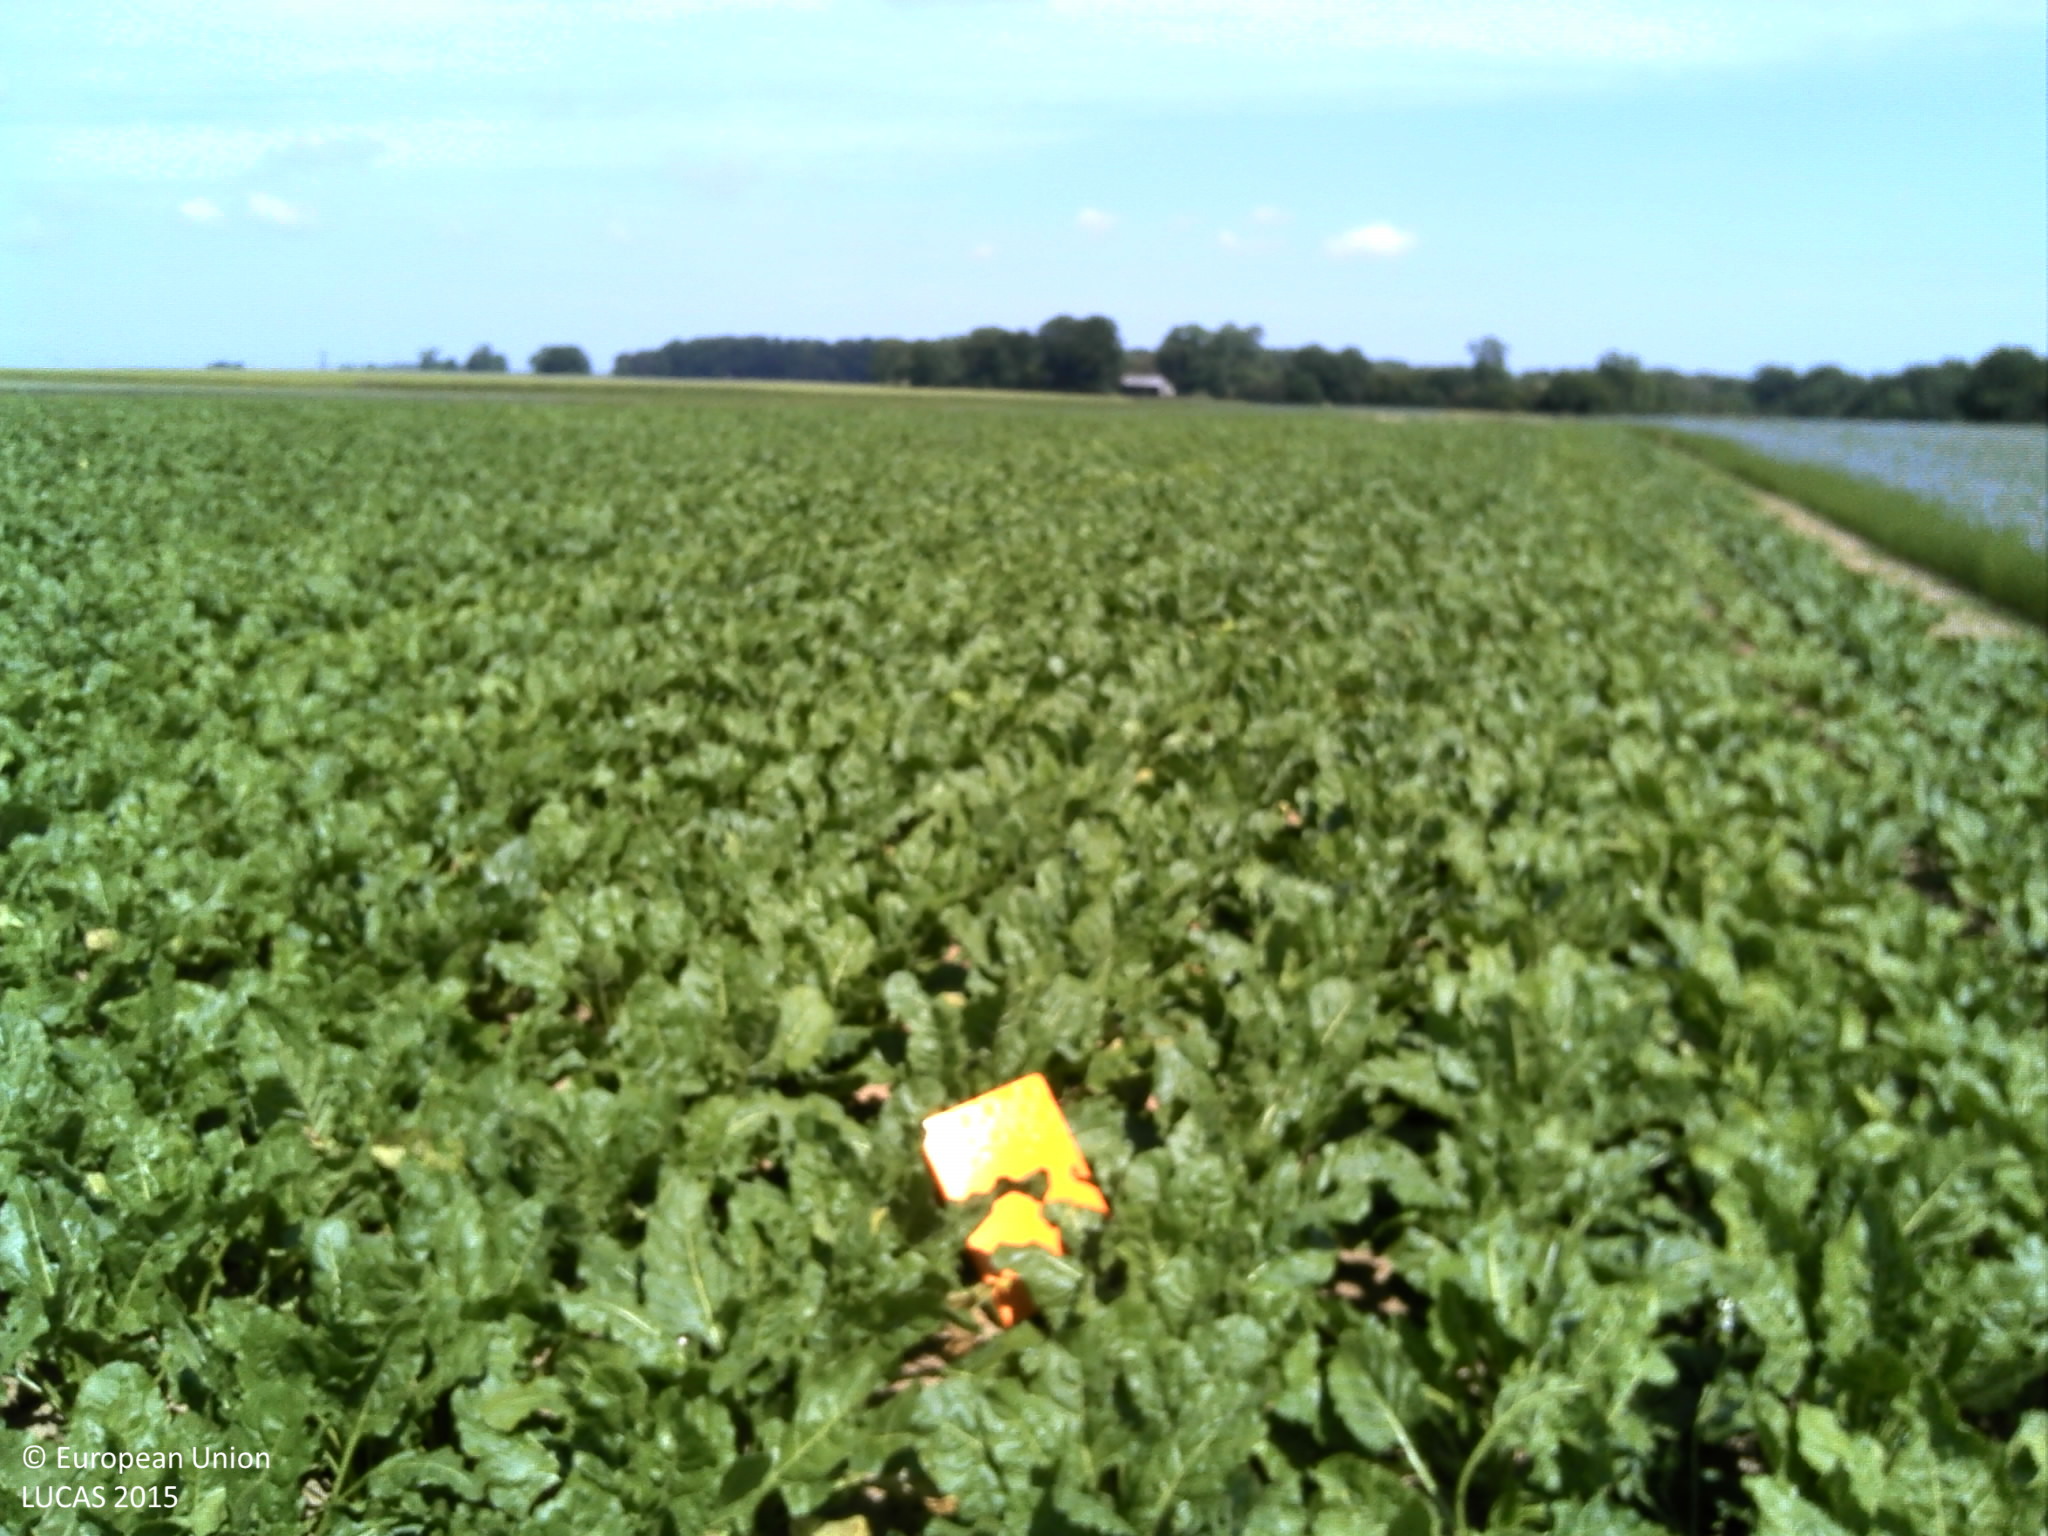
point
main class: Cropland
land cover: Sugar beet
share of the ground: > 75 %
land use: Agriculture (excluding fallow land and kitchen gardens)
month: June
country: FR
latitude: 49.8038
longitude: 1.1556
